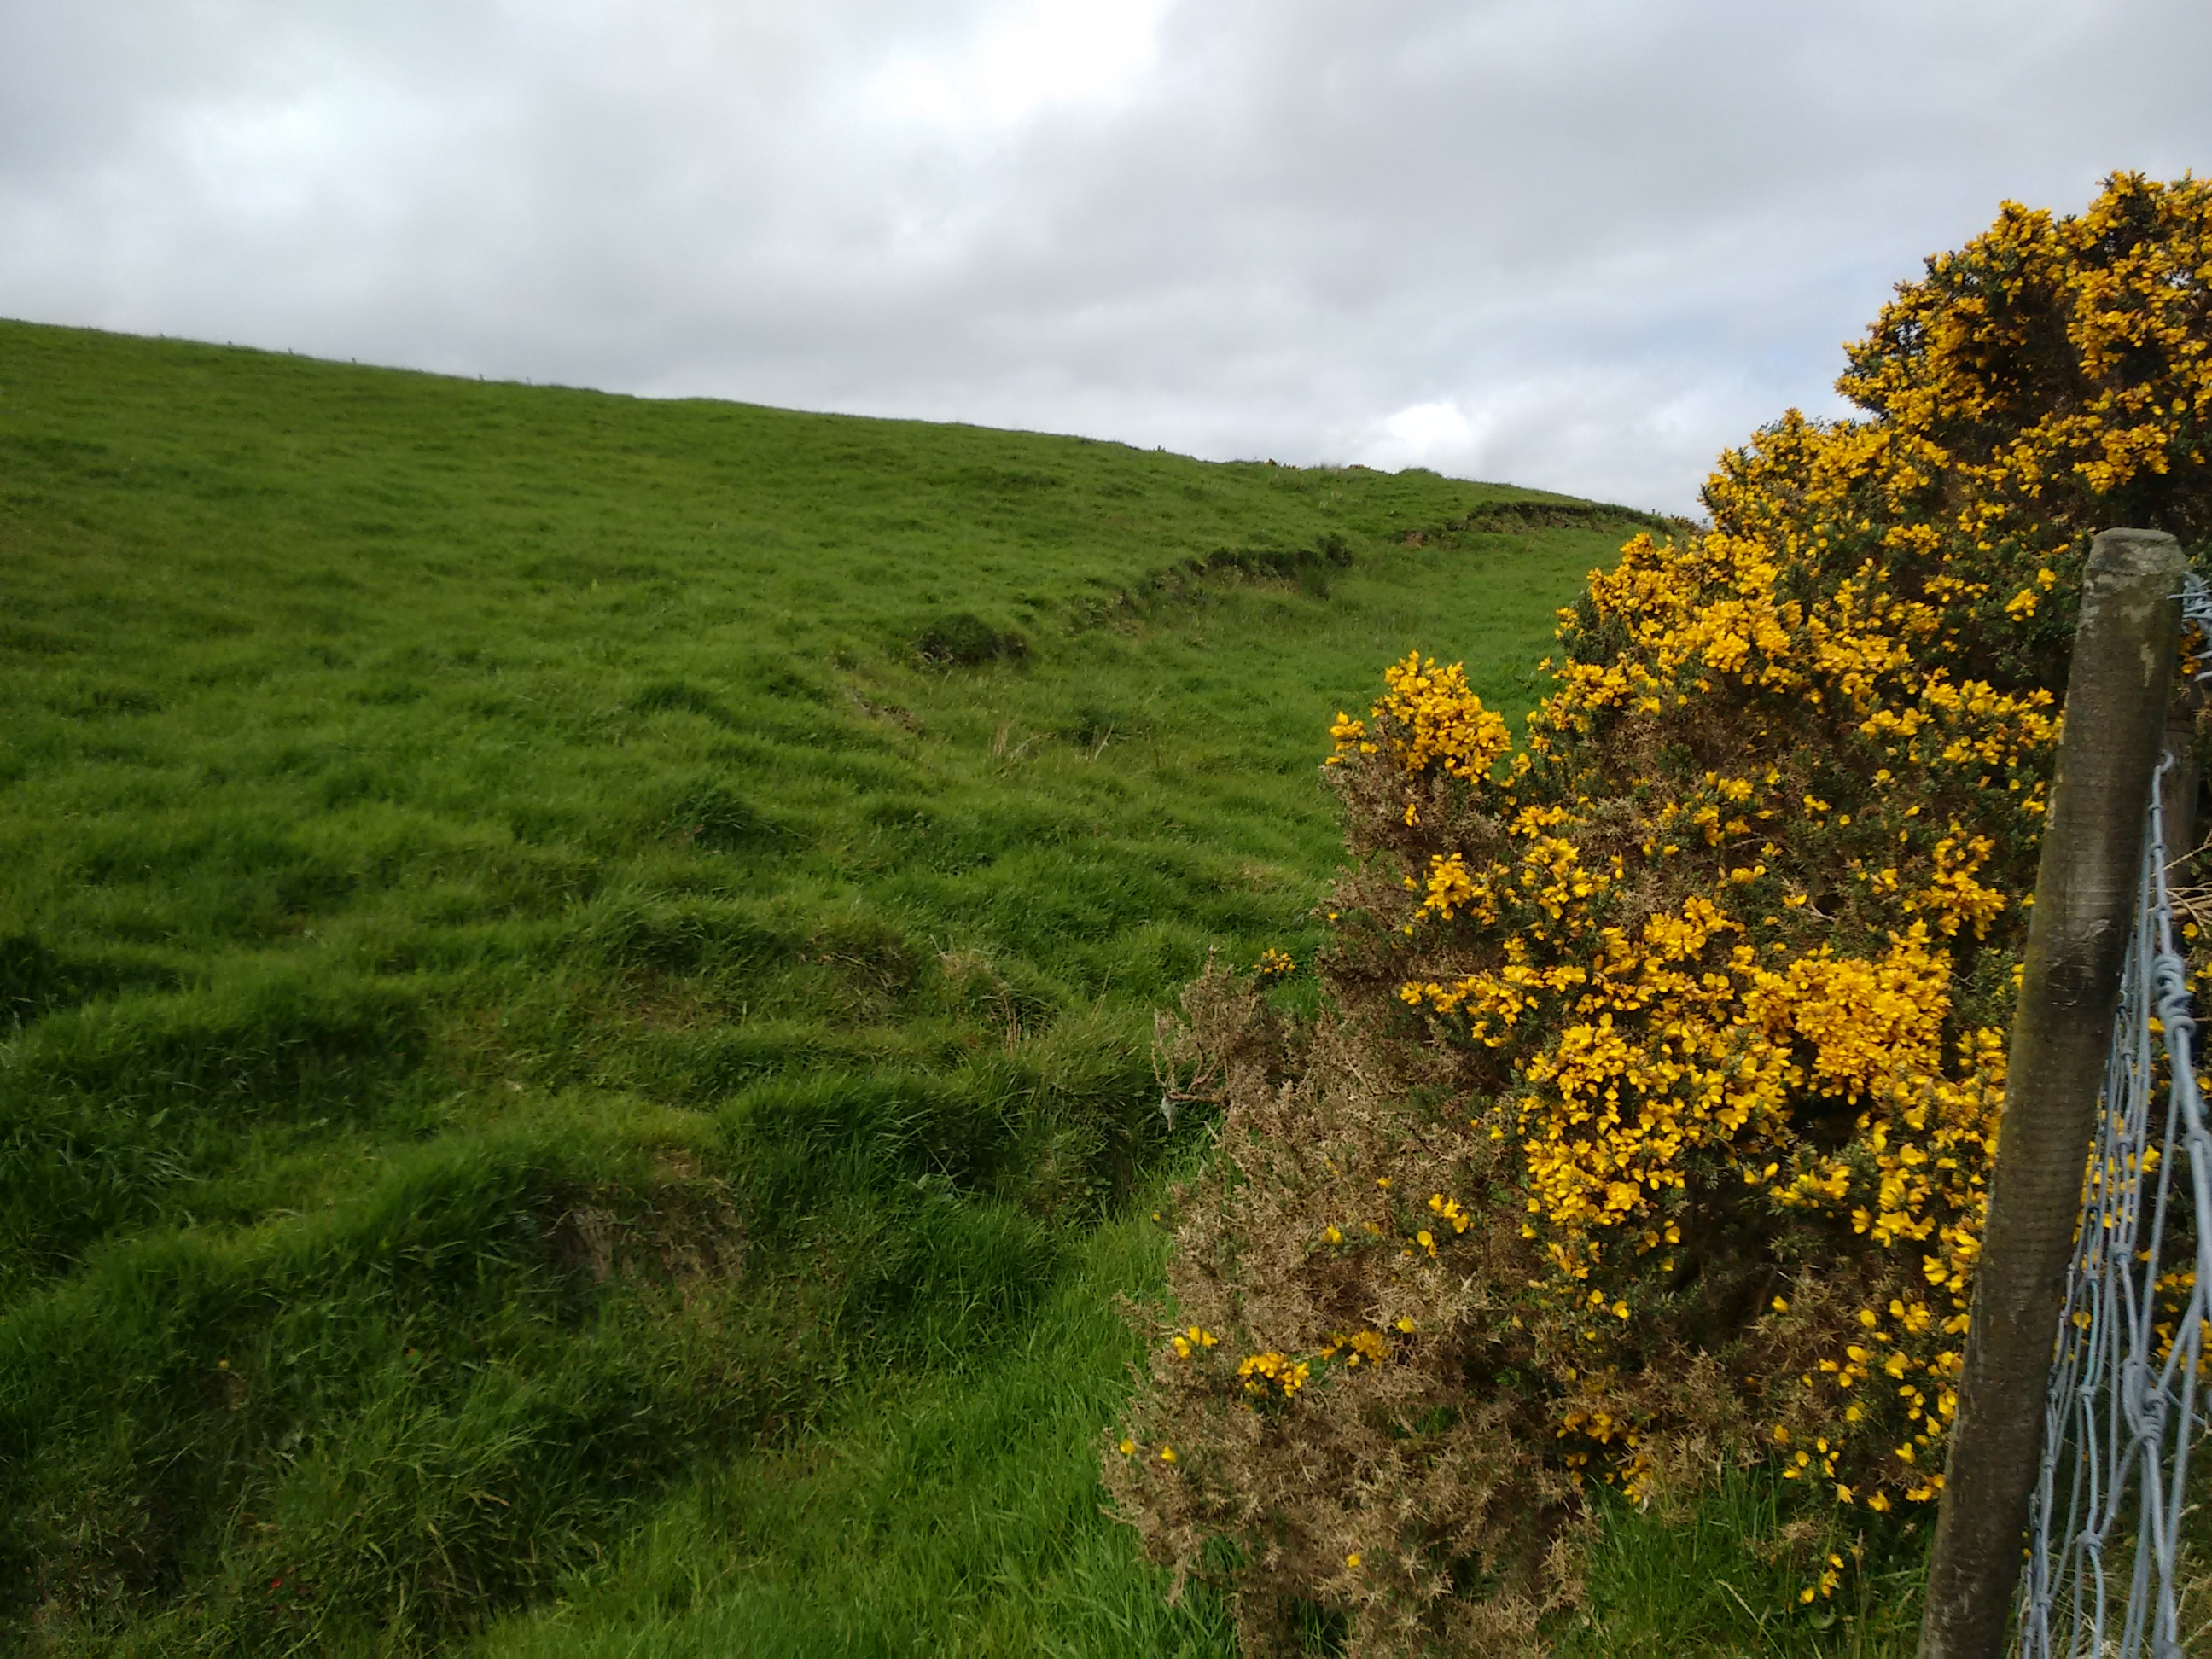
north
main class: Grassland
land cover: Grassland without tree/shrub cover
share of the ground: > 75 %
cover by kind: herbaceous plants 100 %
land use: Agriculture (excluding fallow land and kitchen gardens)
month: May
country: GB
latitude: 54.8818
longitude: -7.2130
